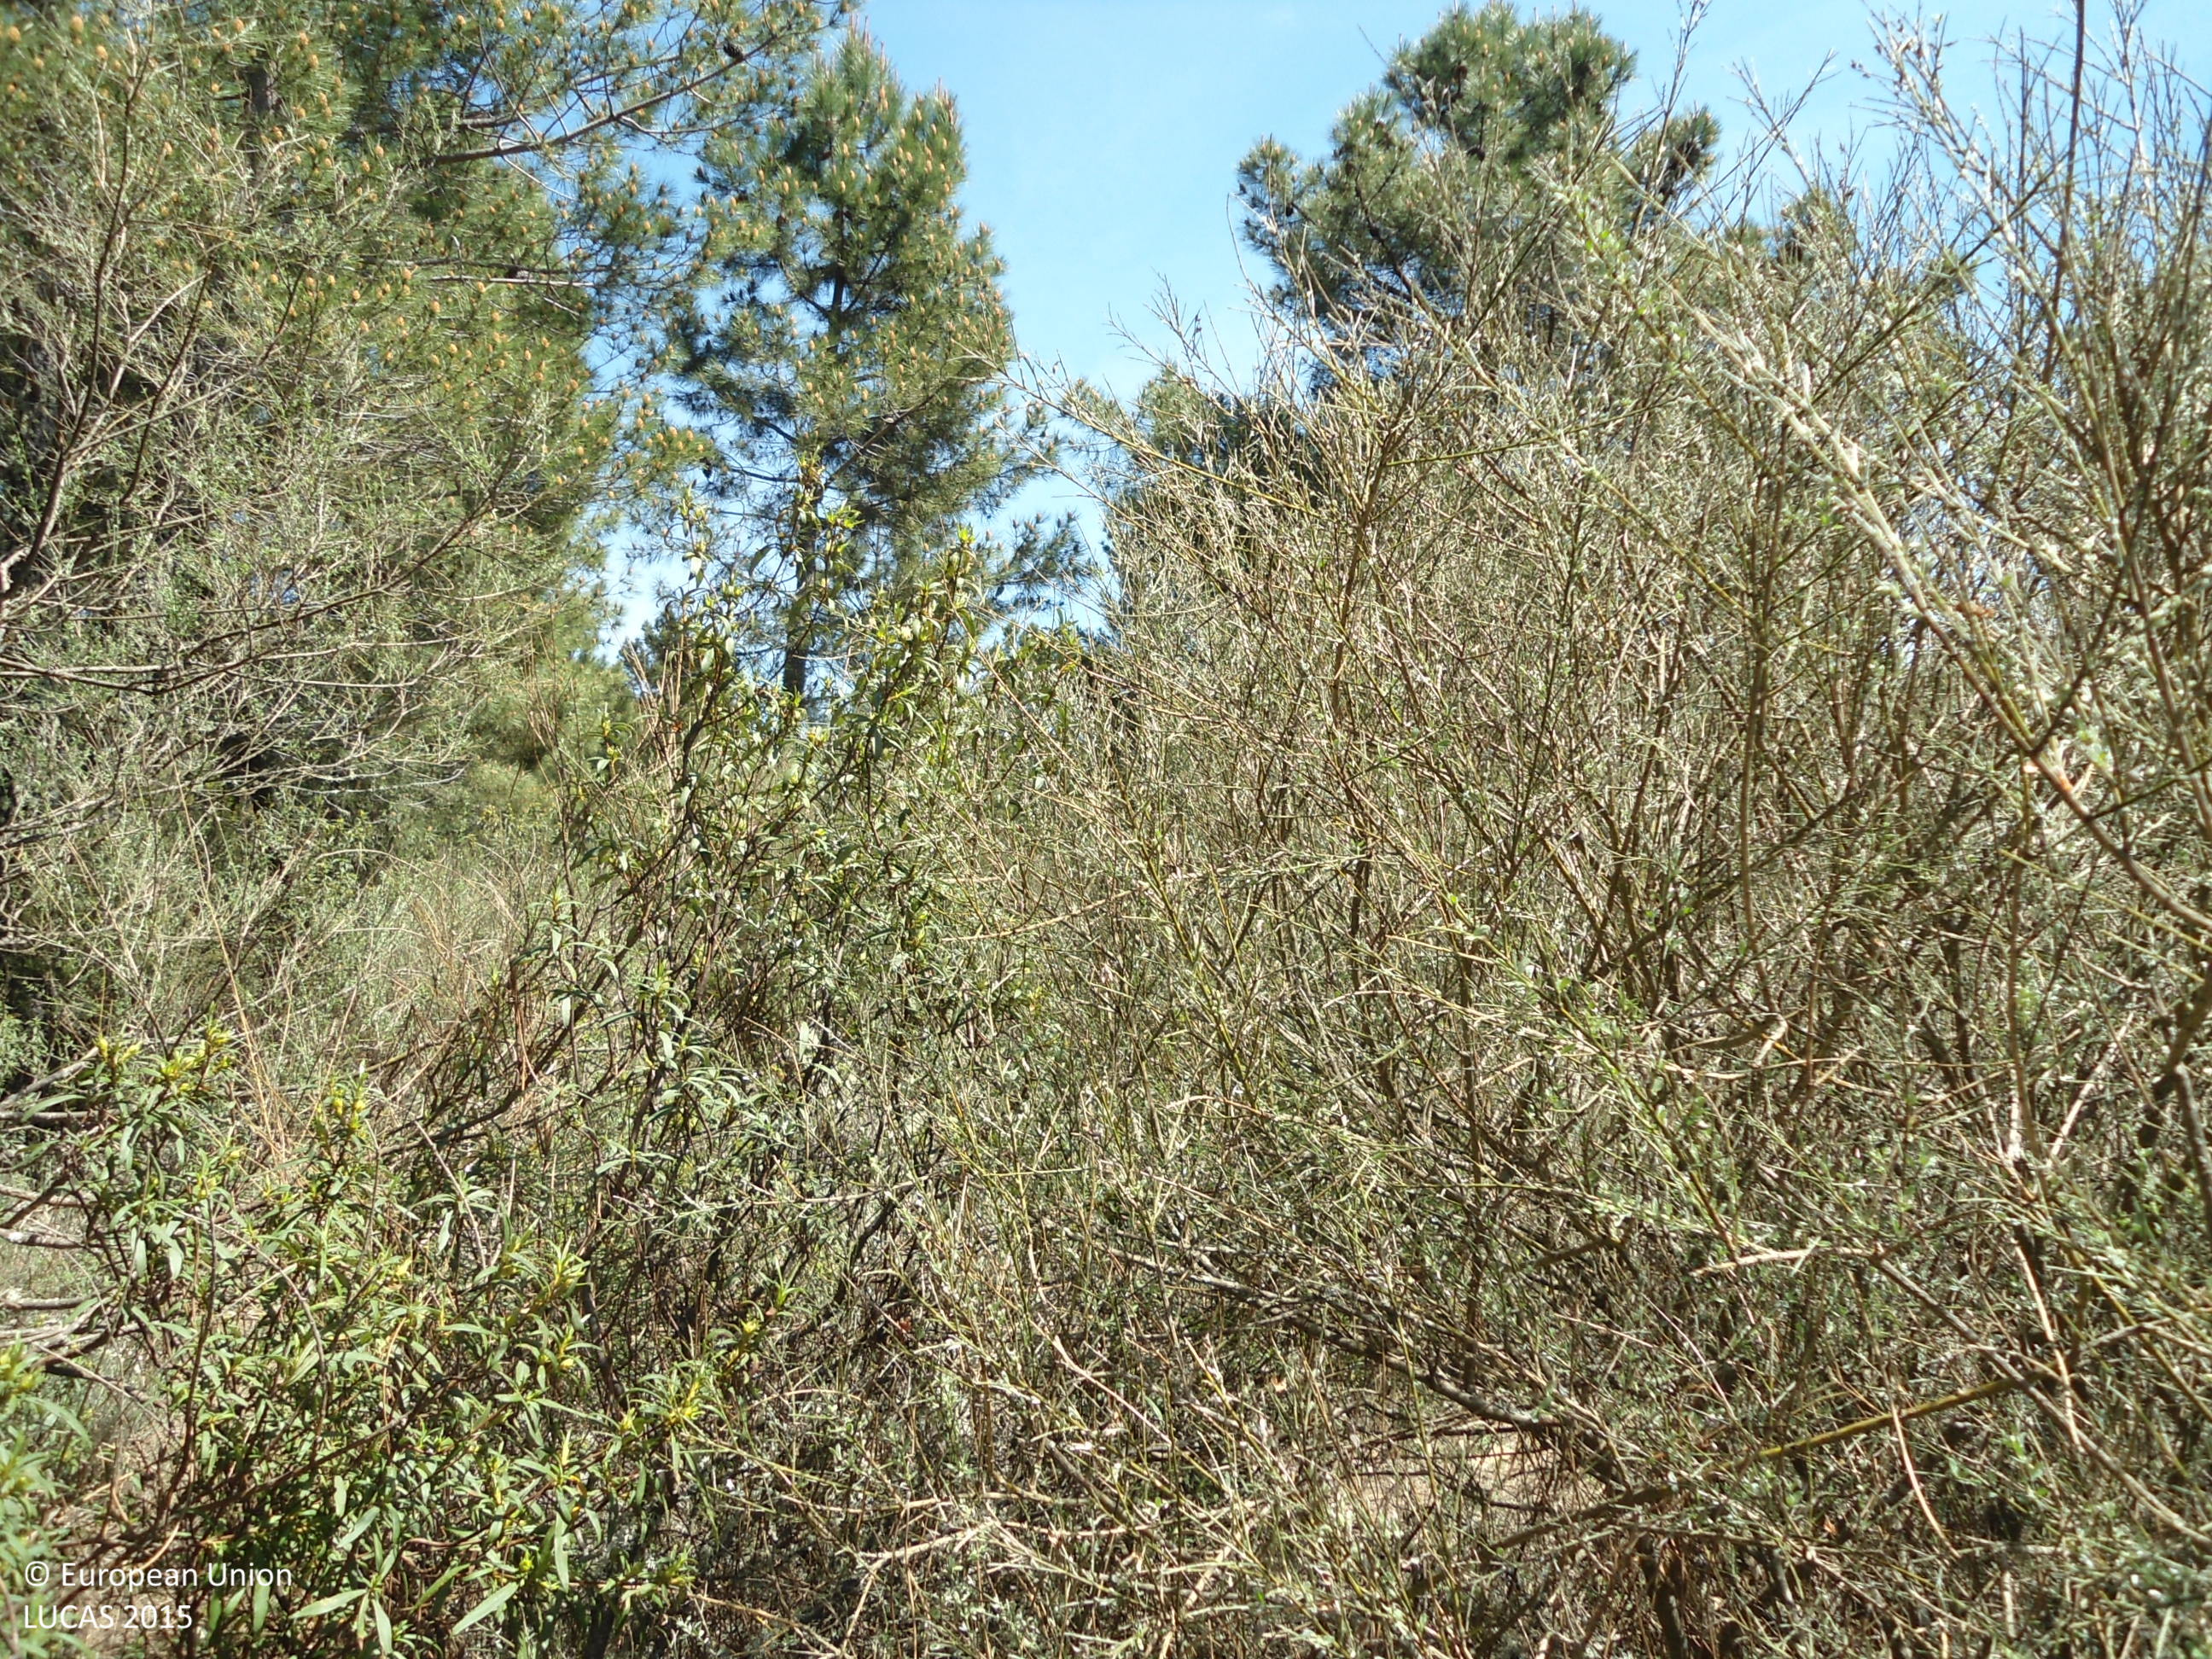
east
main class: Woodland
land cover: Pine dominated coniferous woodland
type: coniferous forest of the mediterranean region
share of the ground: > 75 %
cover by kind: coniferous forest trees 85 %, shrubs 15 %
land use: Forestry
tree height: < 5 m
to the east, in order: Pine dominated coniferous woodland; Shrubland without tree cover
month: April
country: ES
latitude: 41.8596
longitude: -6.2811
